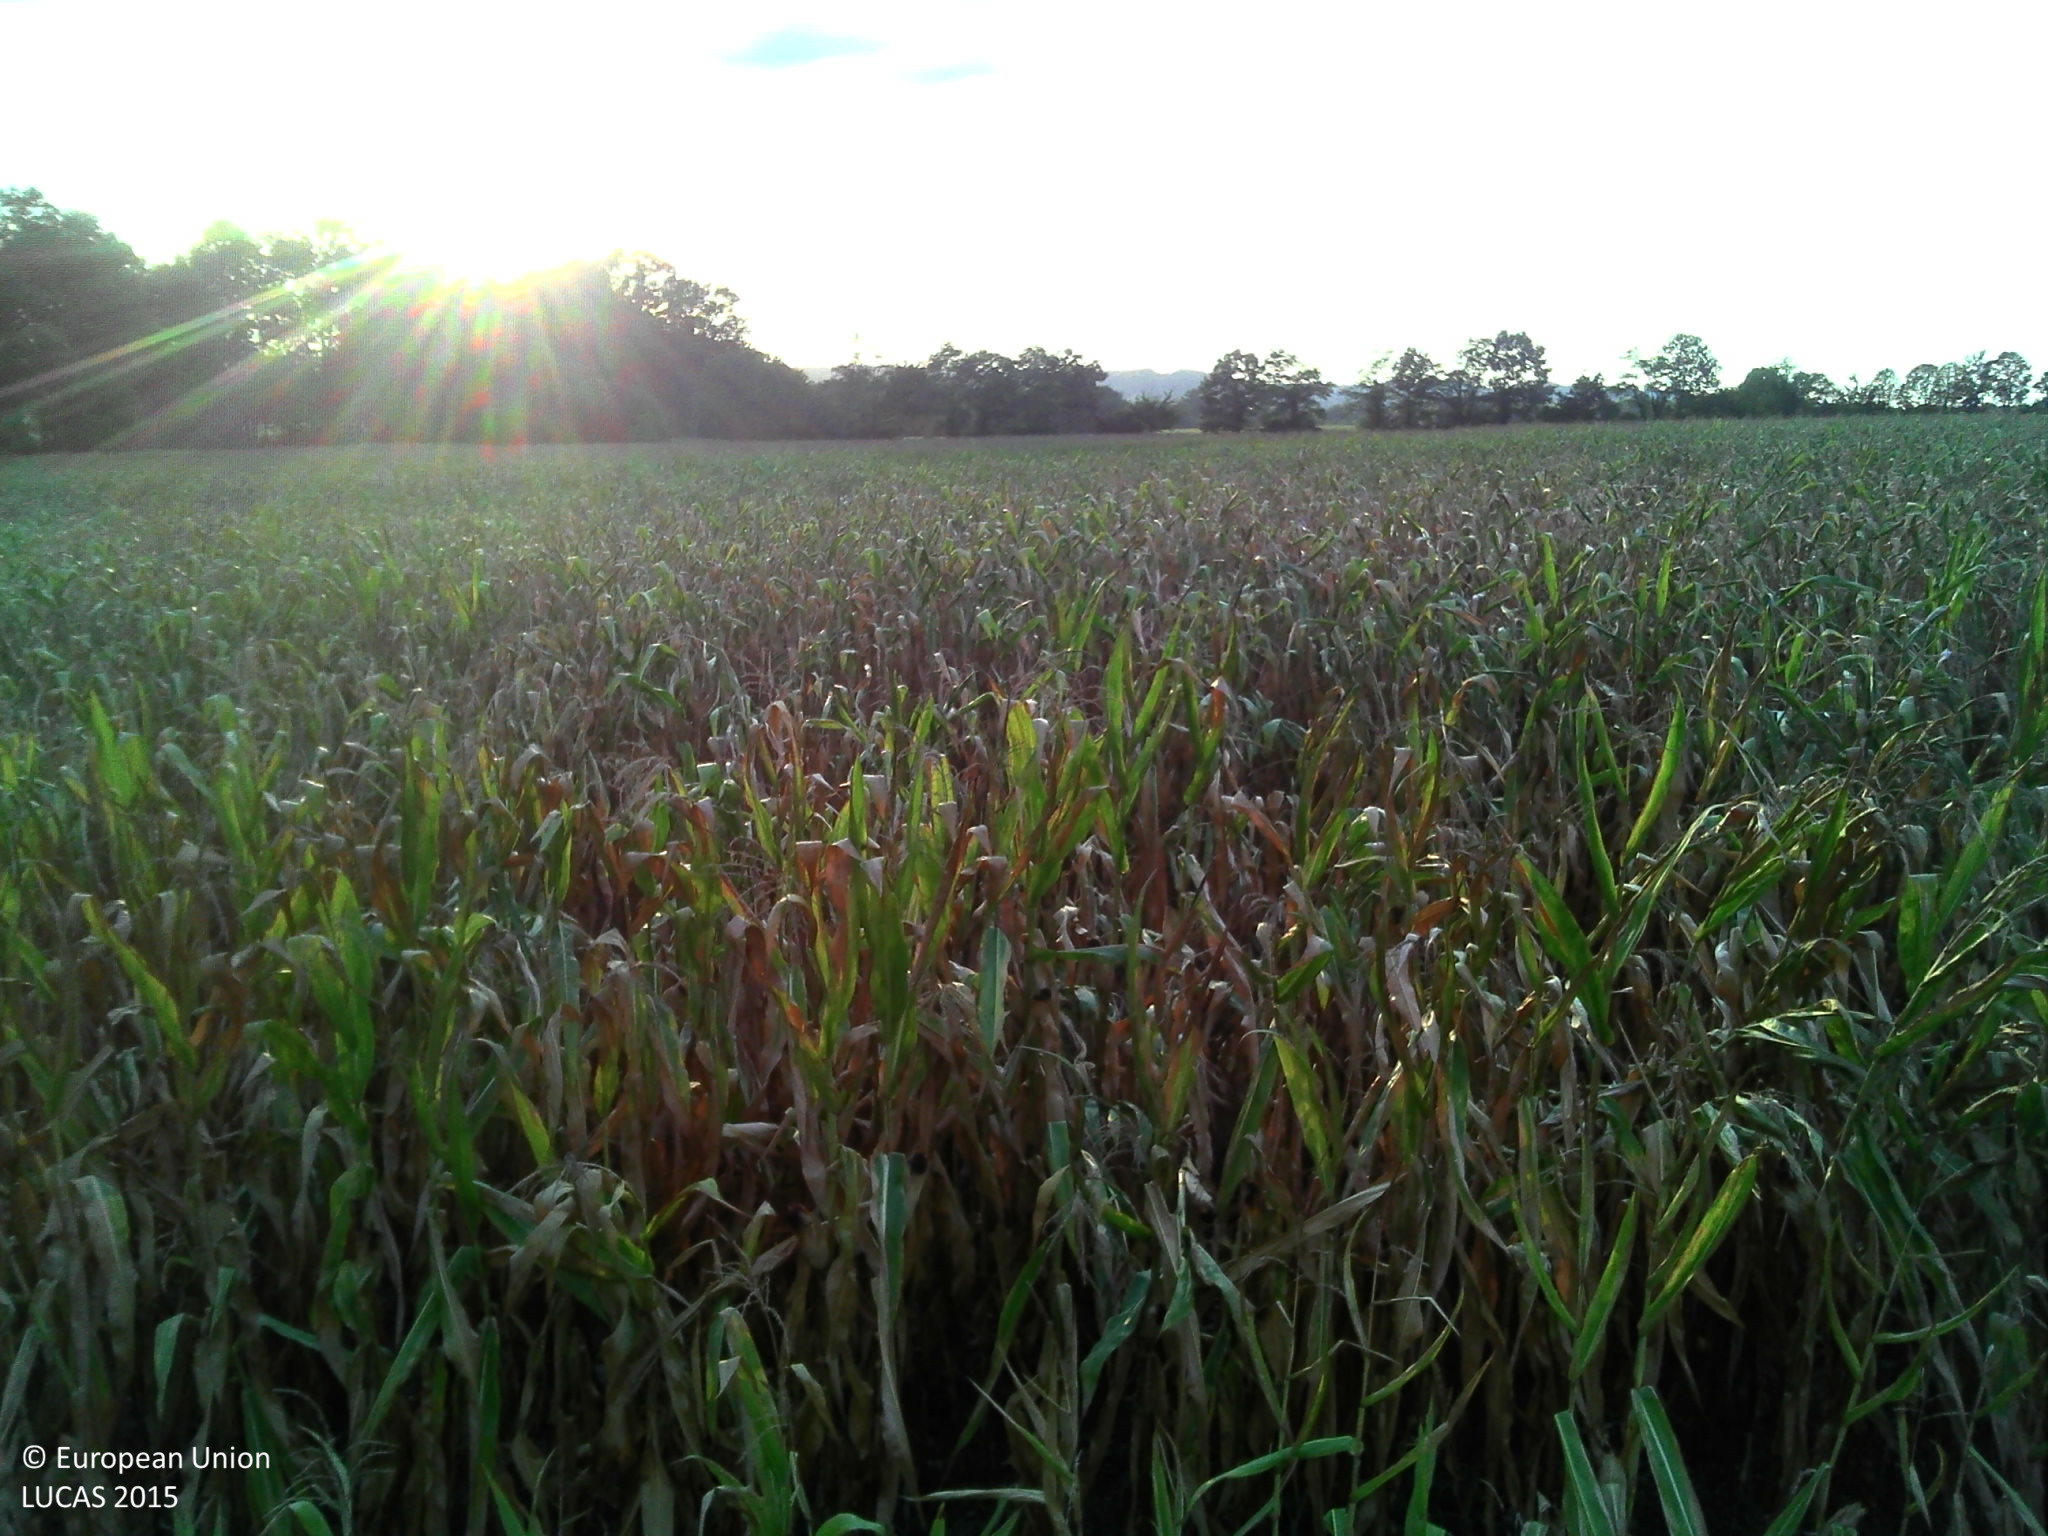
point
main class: Cropland
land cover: Maize
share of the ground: > 75 %
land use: Agriculture (excluding fallow land and kitchen gardens)
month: September
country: FR
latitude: 43.3864
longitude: -0.4389
